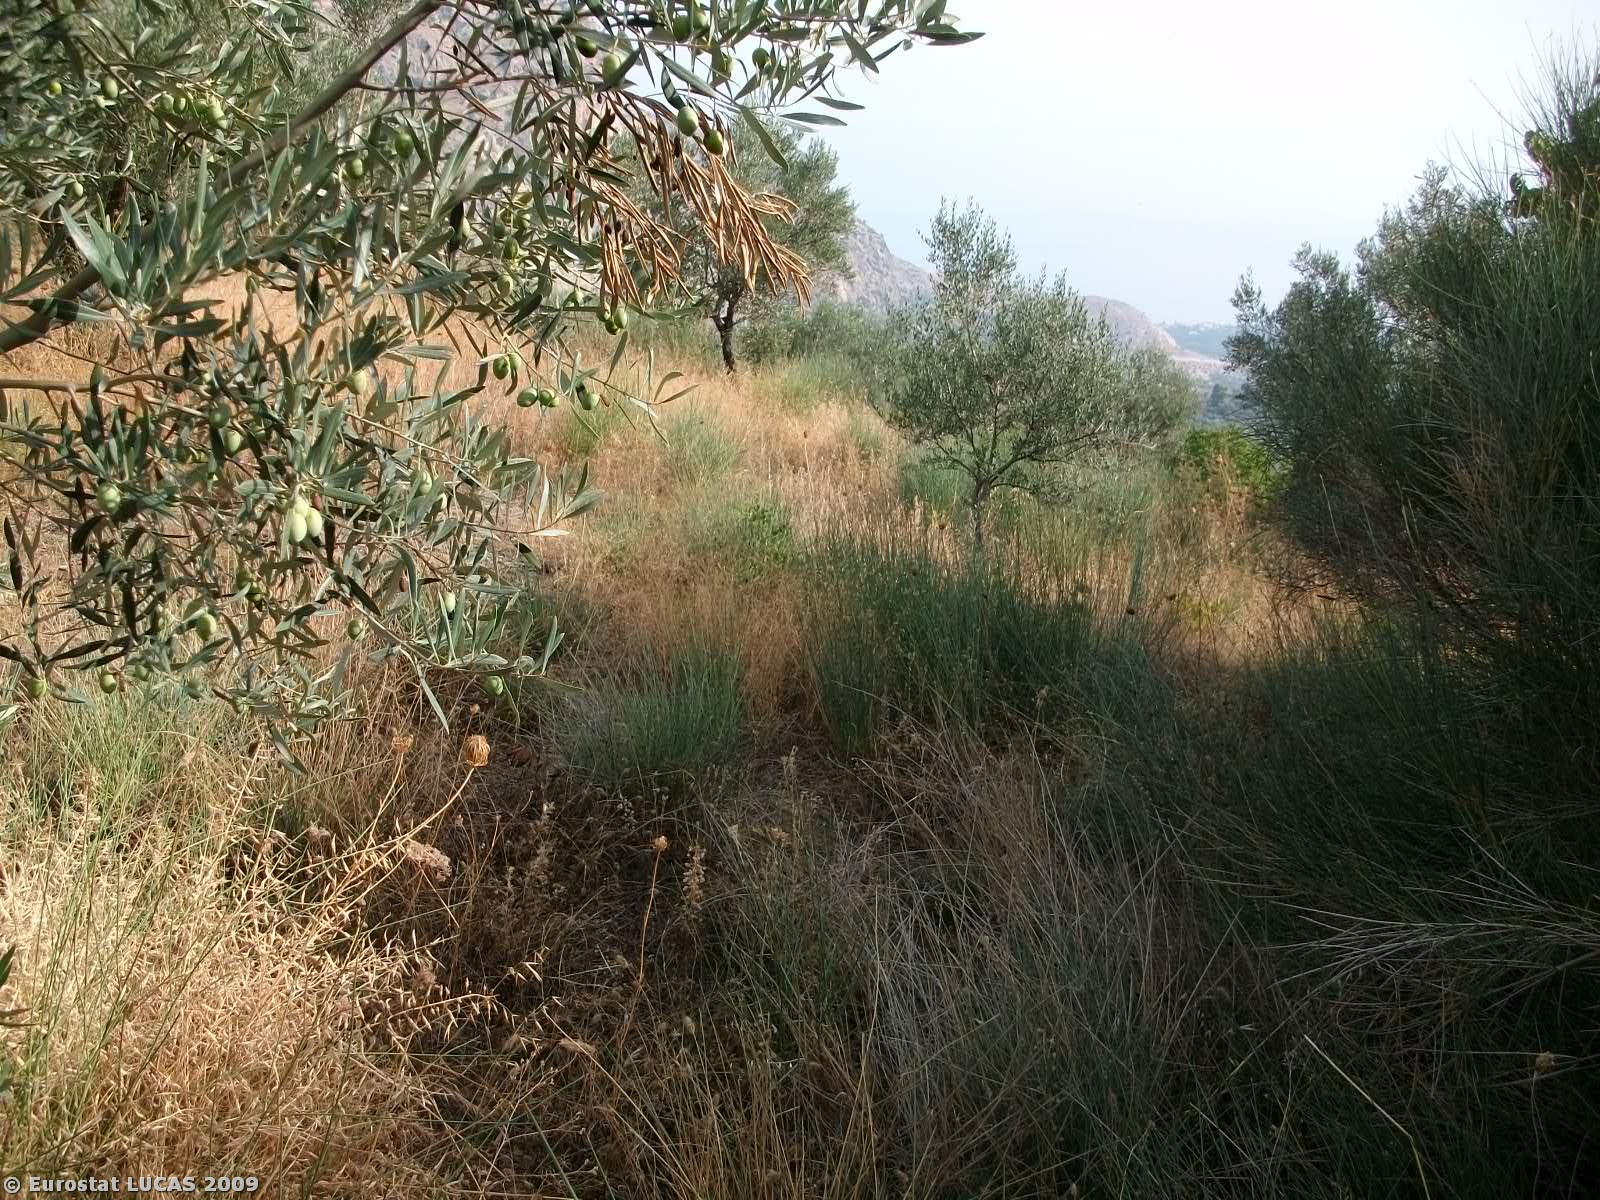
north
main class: Cropland
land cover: Olive groves
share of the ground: 10 - 25 %
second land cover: Grassland with sparse tree/shrub cover
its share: > 75 %
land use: Agriculture (excluding fallow land and kitchen gardens)
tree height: < 5 m
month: September
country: GR
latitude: 38.0649
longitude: 22.5657
